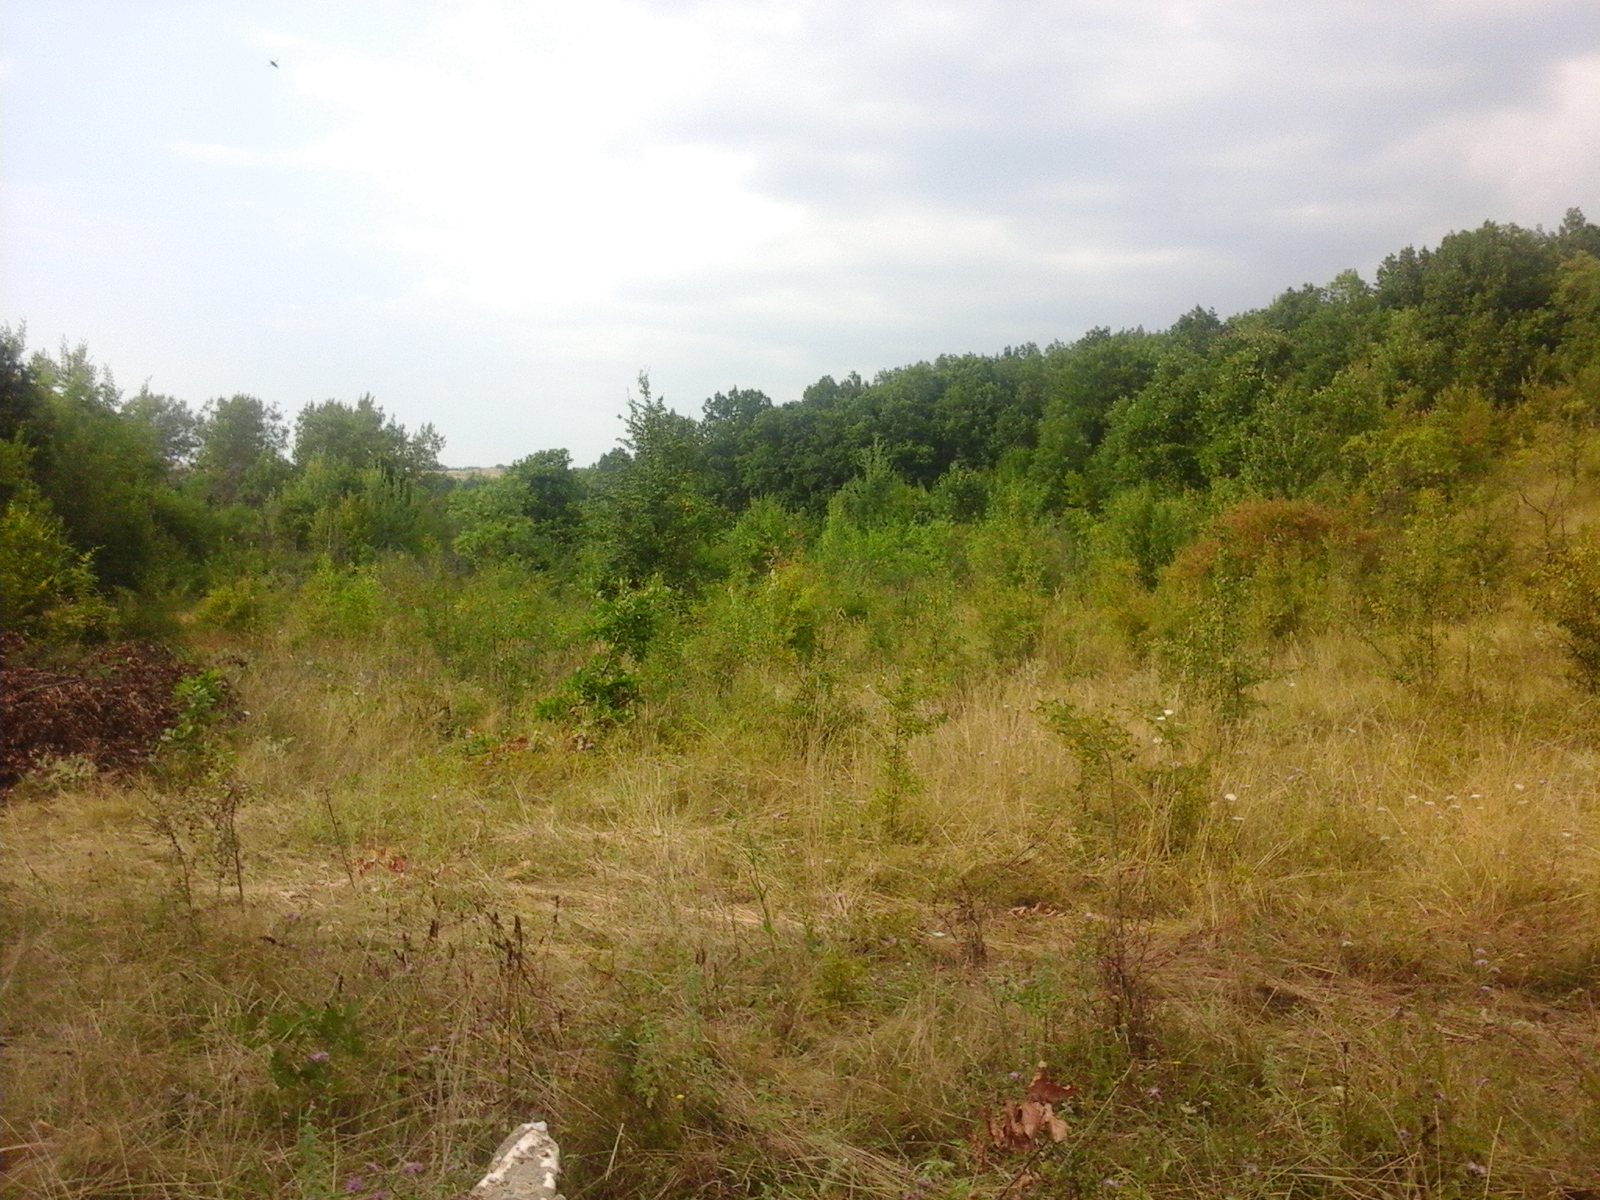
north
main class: Grassland
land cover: Grassland with sparse tree/shrub cover
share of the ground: > 75 %
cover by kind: herbaceous plants 95 %, broadleaved forest trees 5 %
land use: Agriculture (excluding fallow land and kitchen gardens)
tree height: < 5 m
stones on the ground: < 10 %
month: August
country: RO
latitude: 44.8247
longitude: 23.7059
